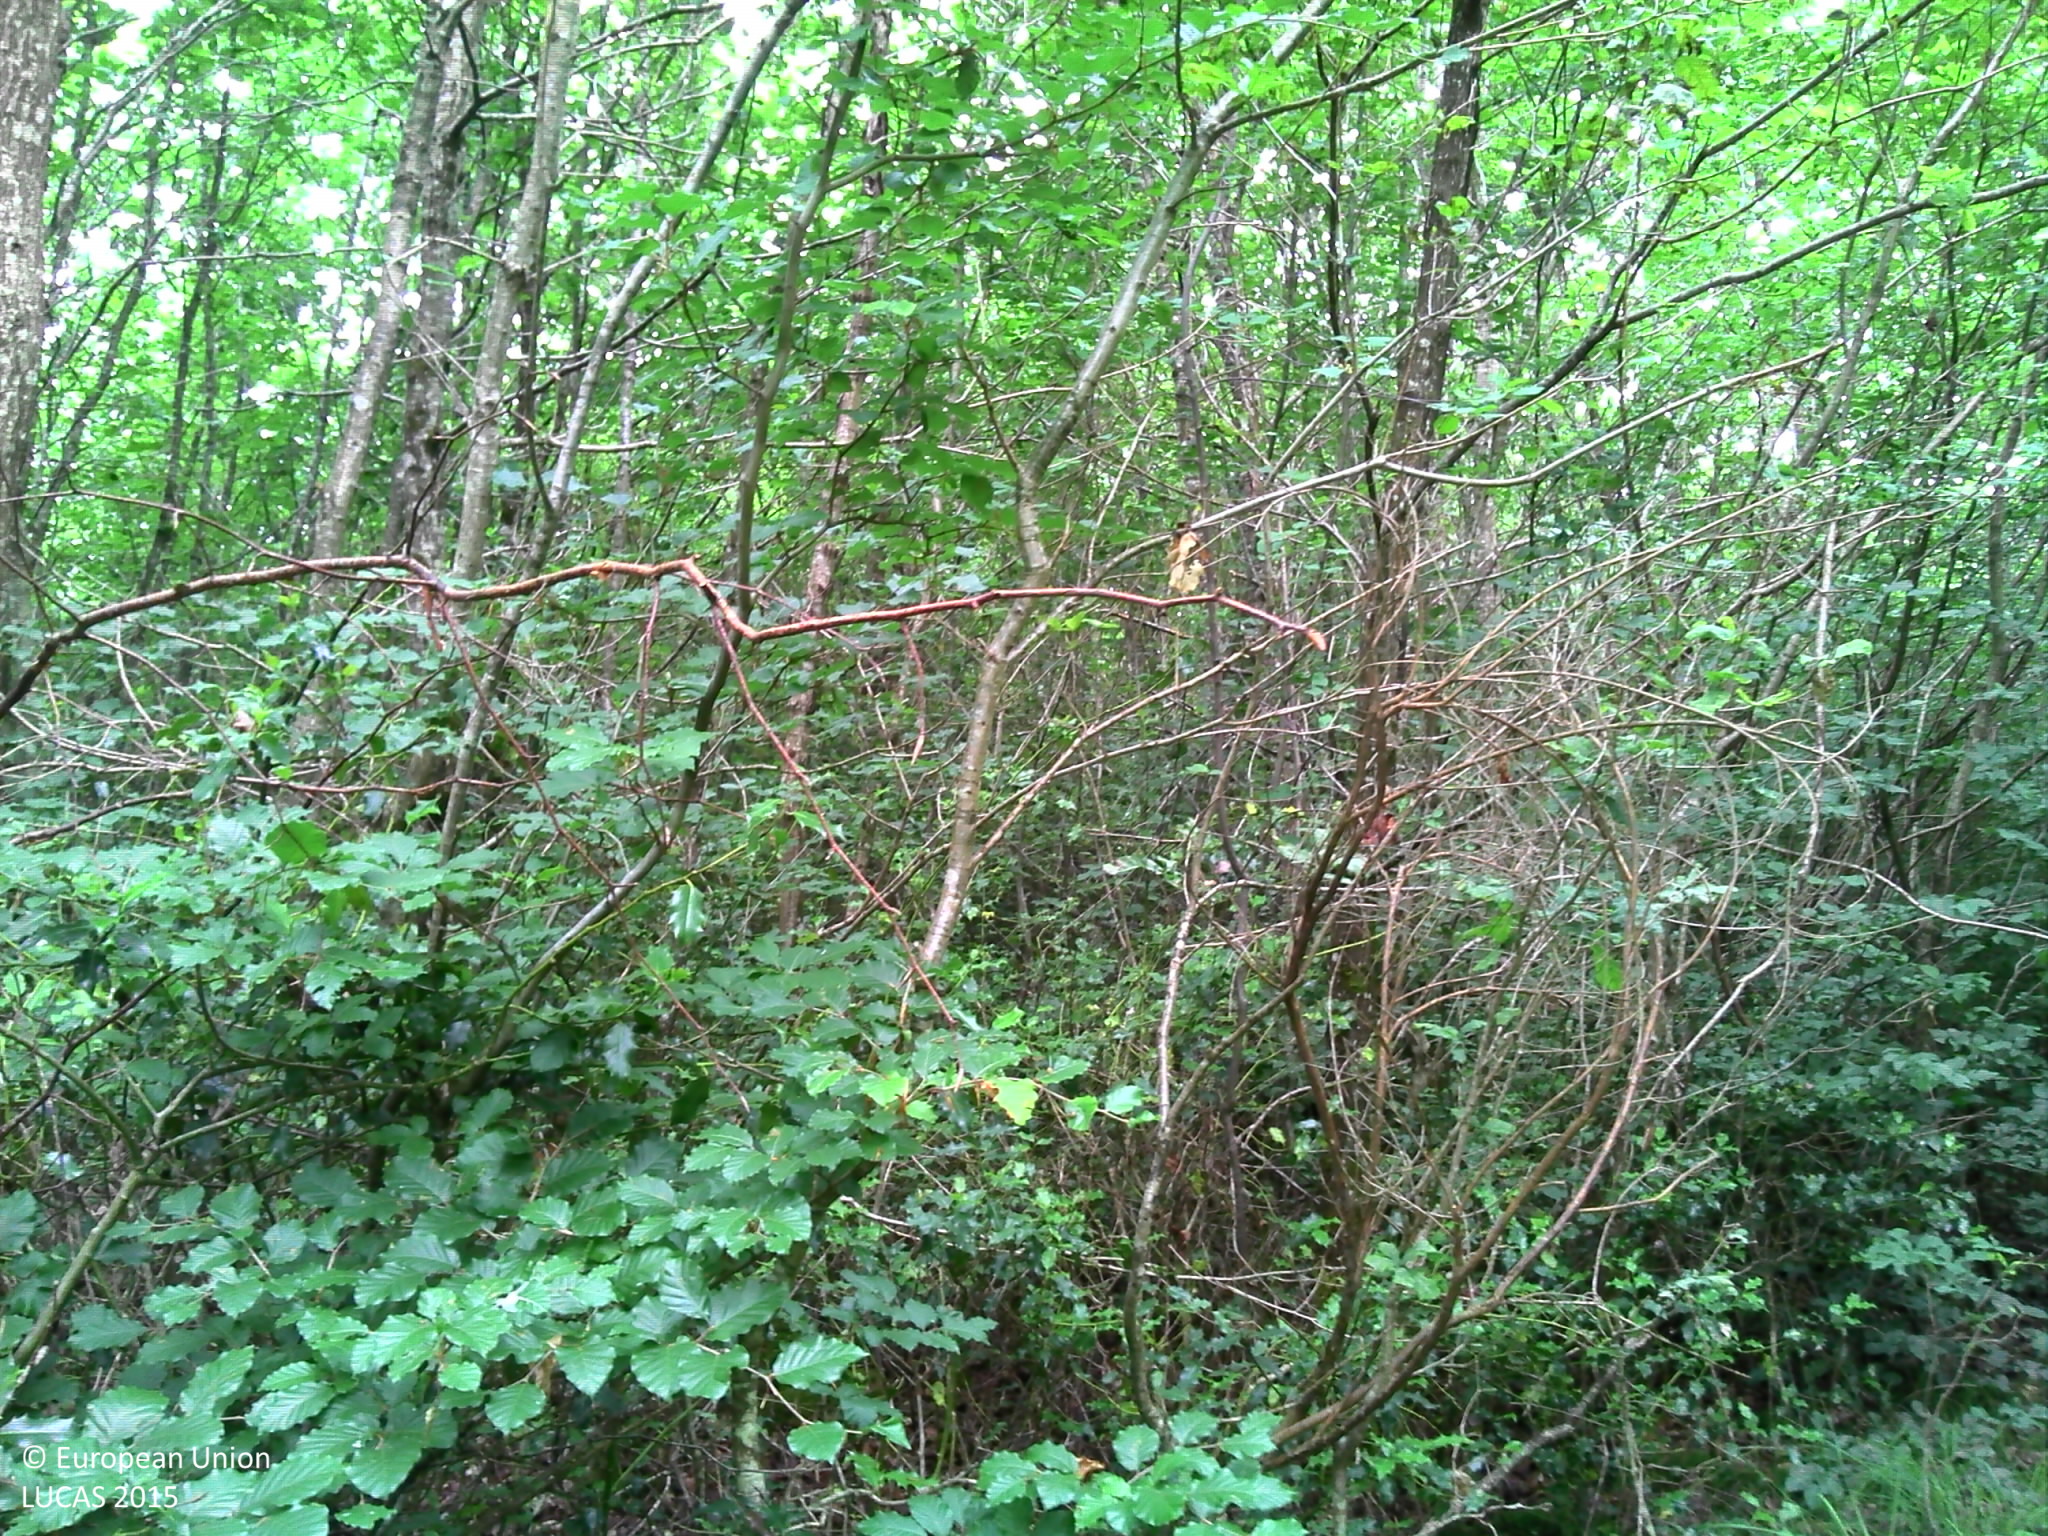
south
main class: Woodland
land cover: Broadleaved woodland
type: acidophilous oak and oak-birch forest
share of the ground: > 75 %
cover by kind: broadleaved forest trees 90 %, shrubs 10 %
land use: Forestry
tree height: > 5 m
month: June
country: FR
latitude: 46.6435
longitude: 2.6923
